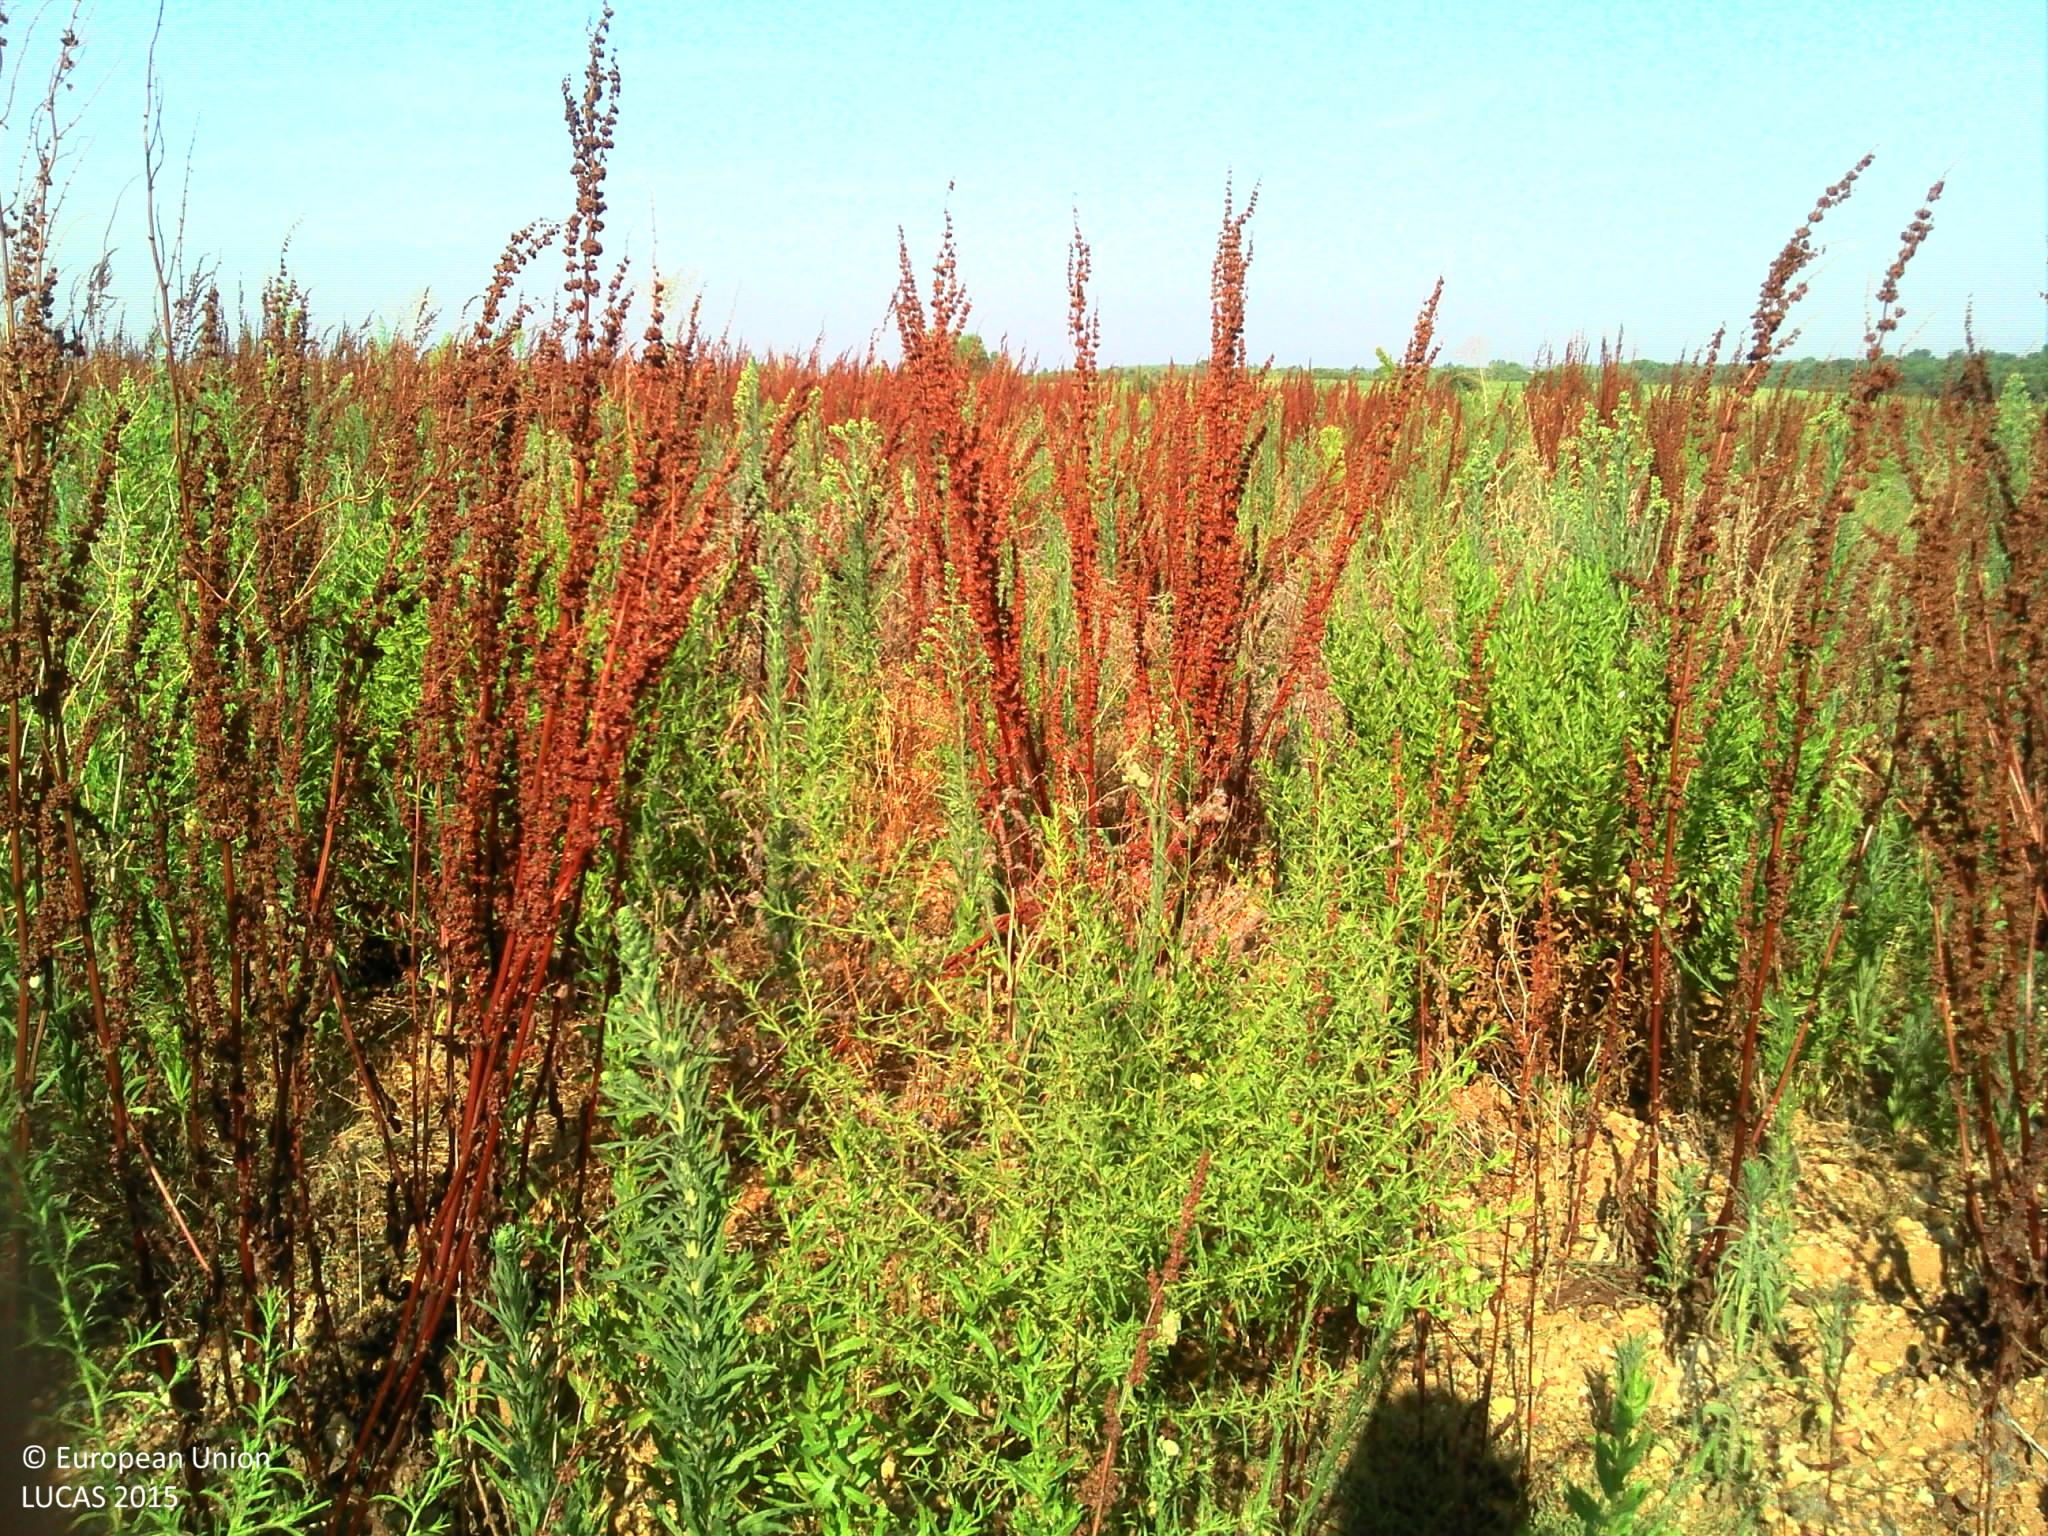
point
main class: Grassland
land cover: Spontaneously vegetated surfaces
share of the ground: > 75 %
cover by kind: herbaceous plants 95 %, unconsolidated bare surface 5 %
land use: Semi-natural and natural areas not in use
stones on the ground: > 50 %
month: August
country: FR
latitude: 43.3400
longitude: 3.3364
